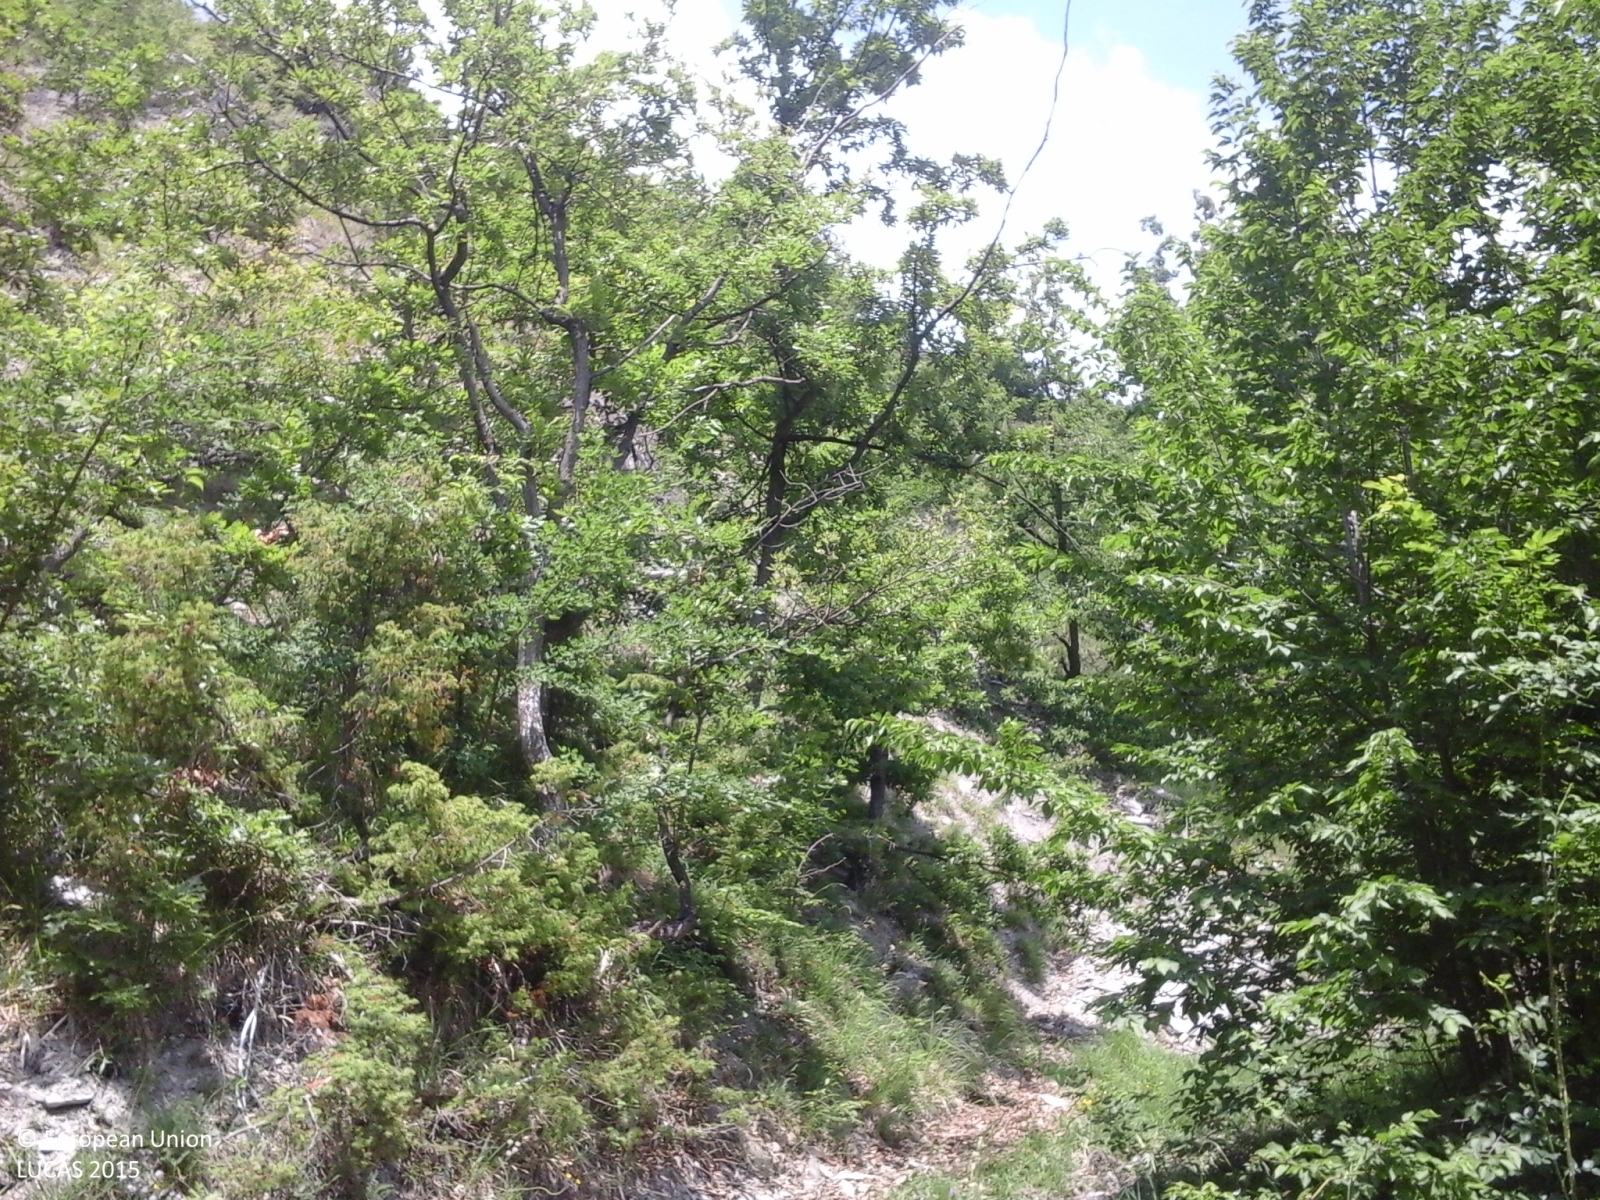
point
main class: Woodland
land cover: Broadleaved woodland
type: thermophilous deciduous forest
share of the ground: > 75 %
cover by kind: broadleaved forest trees 60 %, shrubs 20 %, consolidated bare surface 15 %, herbaceous plants 5 %
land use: Forestry
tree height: > 5 m
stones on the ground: > 50 %
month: June
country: IT
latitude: 44.2582
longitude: 10.6623
